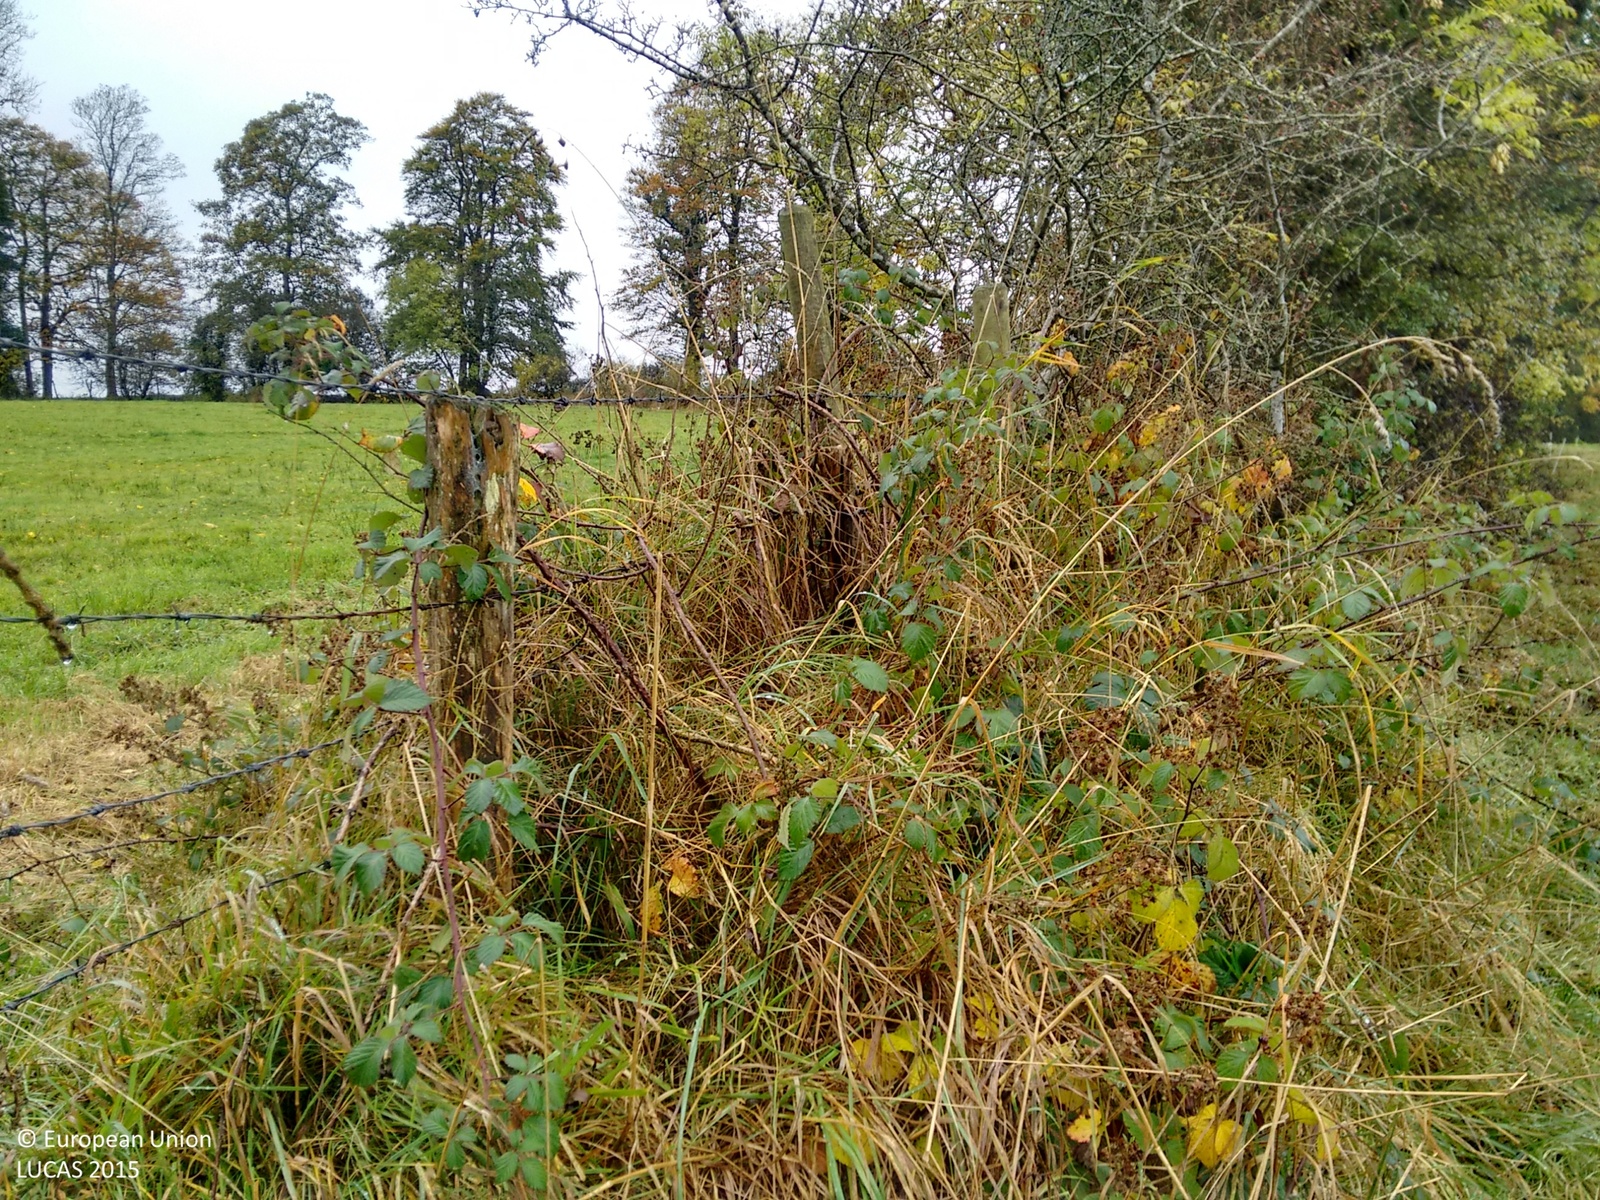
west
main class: Grassland
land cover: Grassland without tree/shrub cover
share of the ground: > 75 %
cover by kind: herbaceous plants 100 %
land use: Agriculture (excluding fallow land and kitchen gardens)
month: October
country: IE
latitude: 53.8487
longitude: -8.0995
